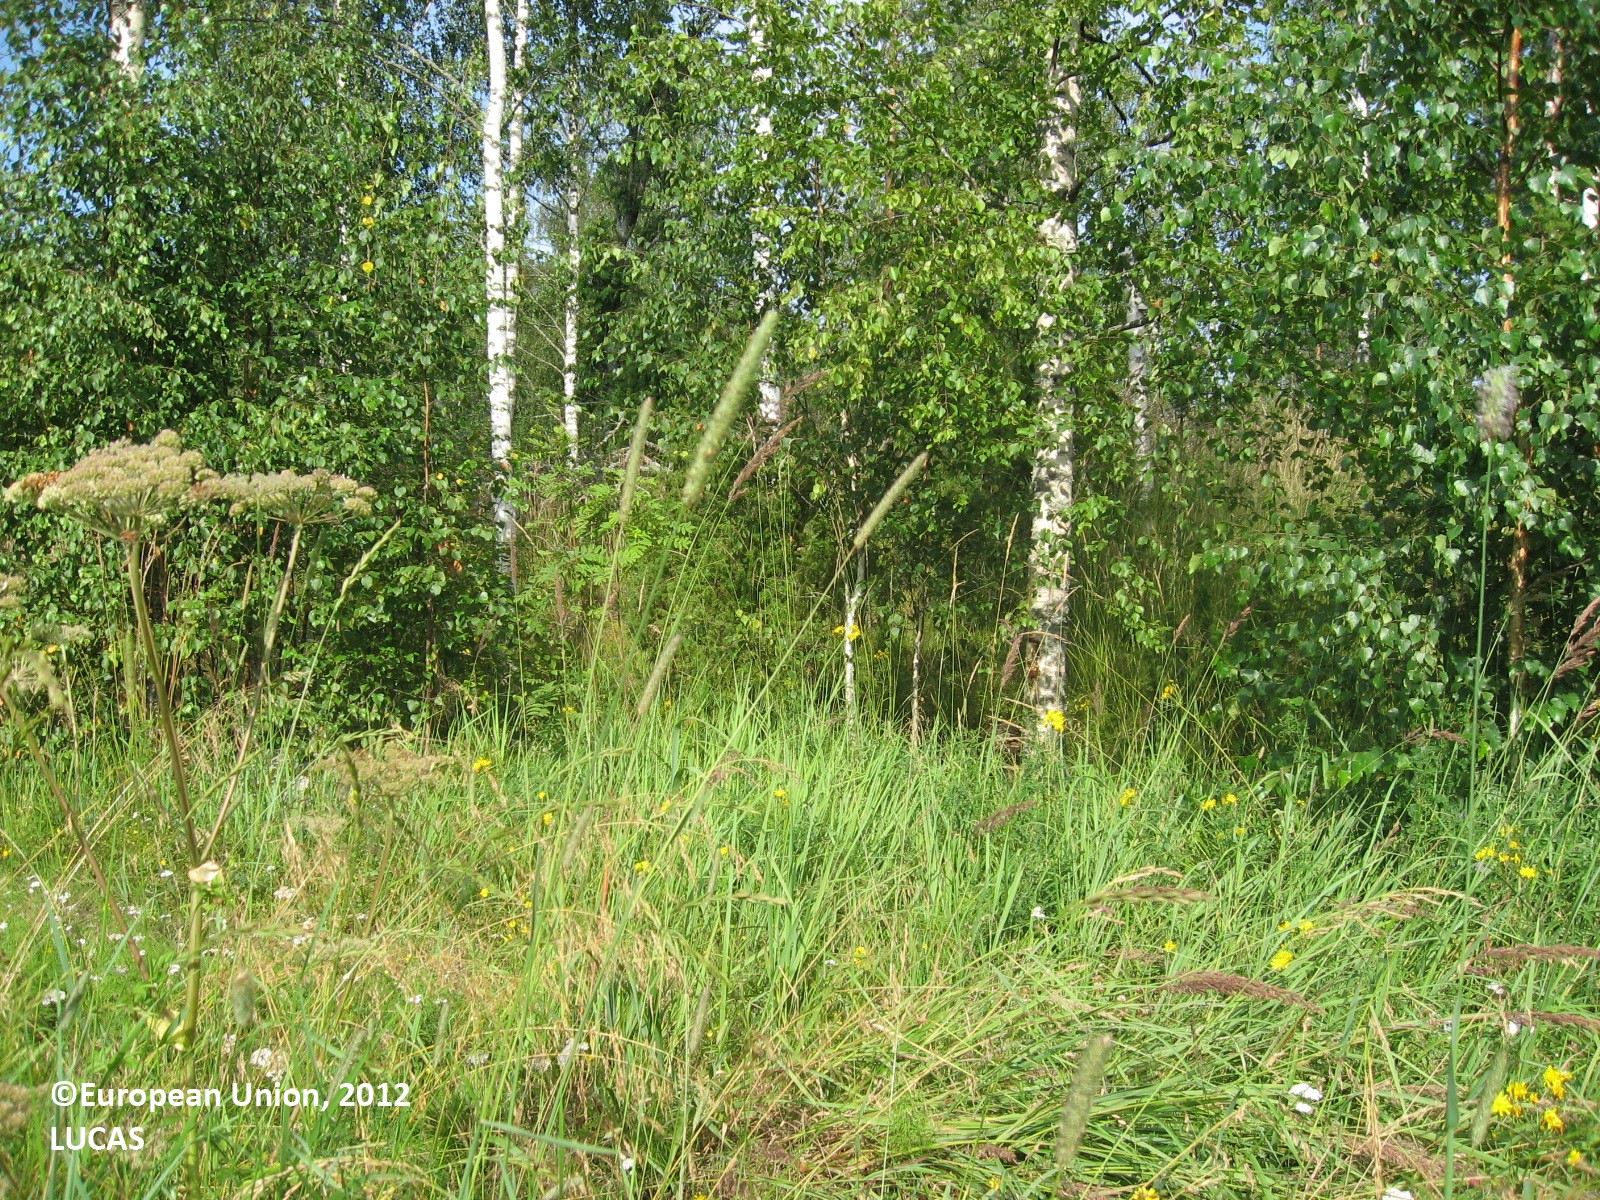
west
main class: Cropland
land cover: Oats
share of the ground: > 75 %
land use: Agriculture (excluding fallow land and kitchen gardens)
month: August
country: FI
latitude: 61.5147
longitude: 25.9392
